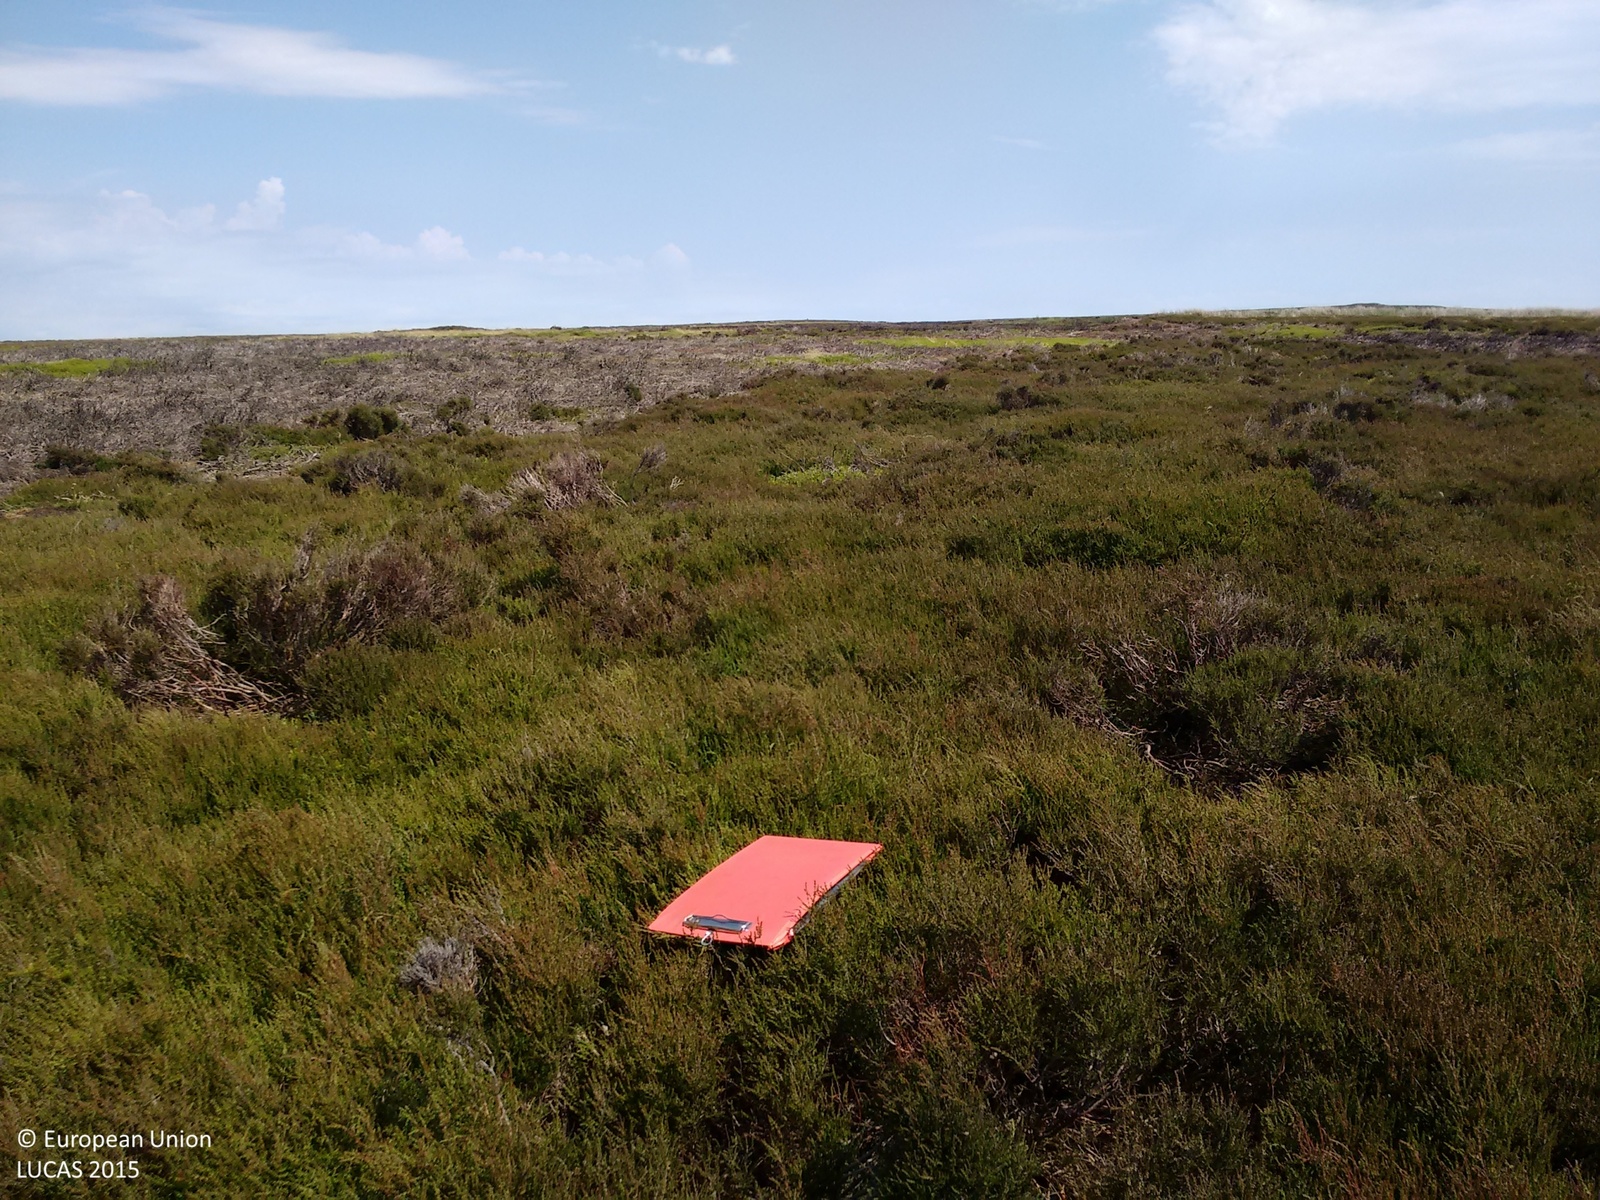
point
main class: Shrubland
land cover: Shrubland without tree cover
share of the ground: > 75 %
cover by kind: shrubs 100 %
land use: Semi-natural and natural areas not in use
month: July
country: GB
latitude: 54.3940
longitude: -0.9299
